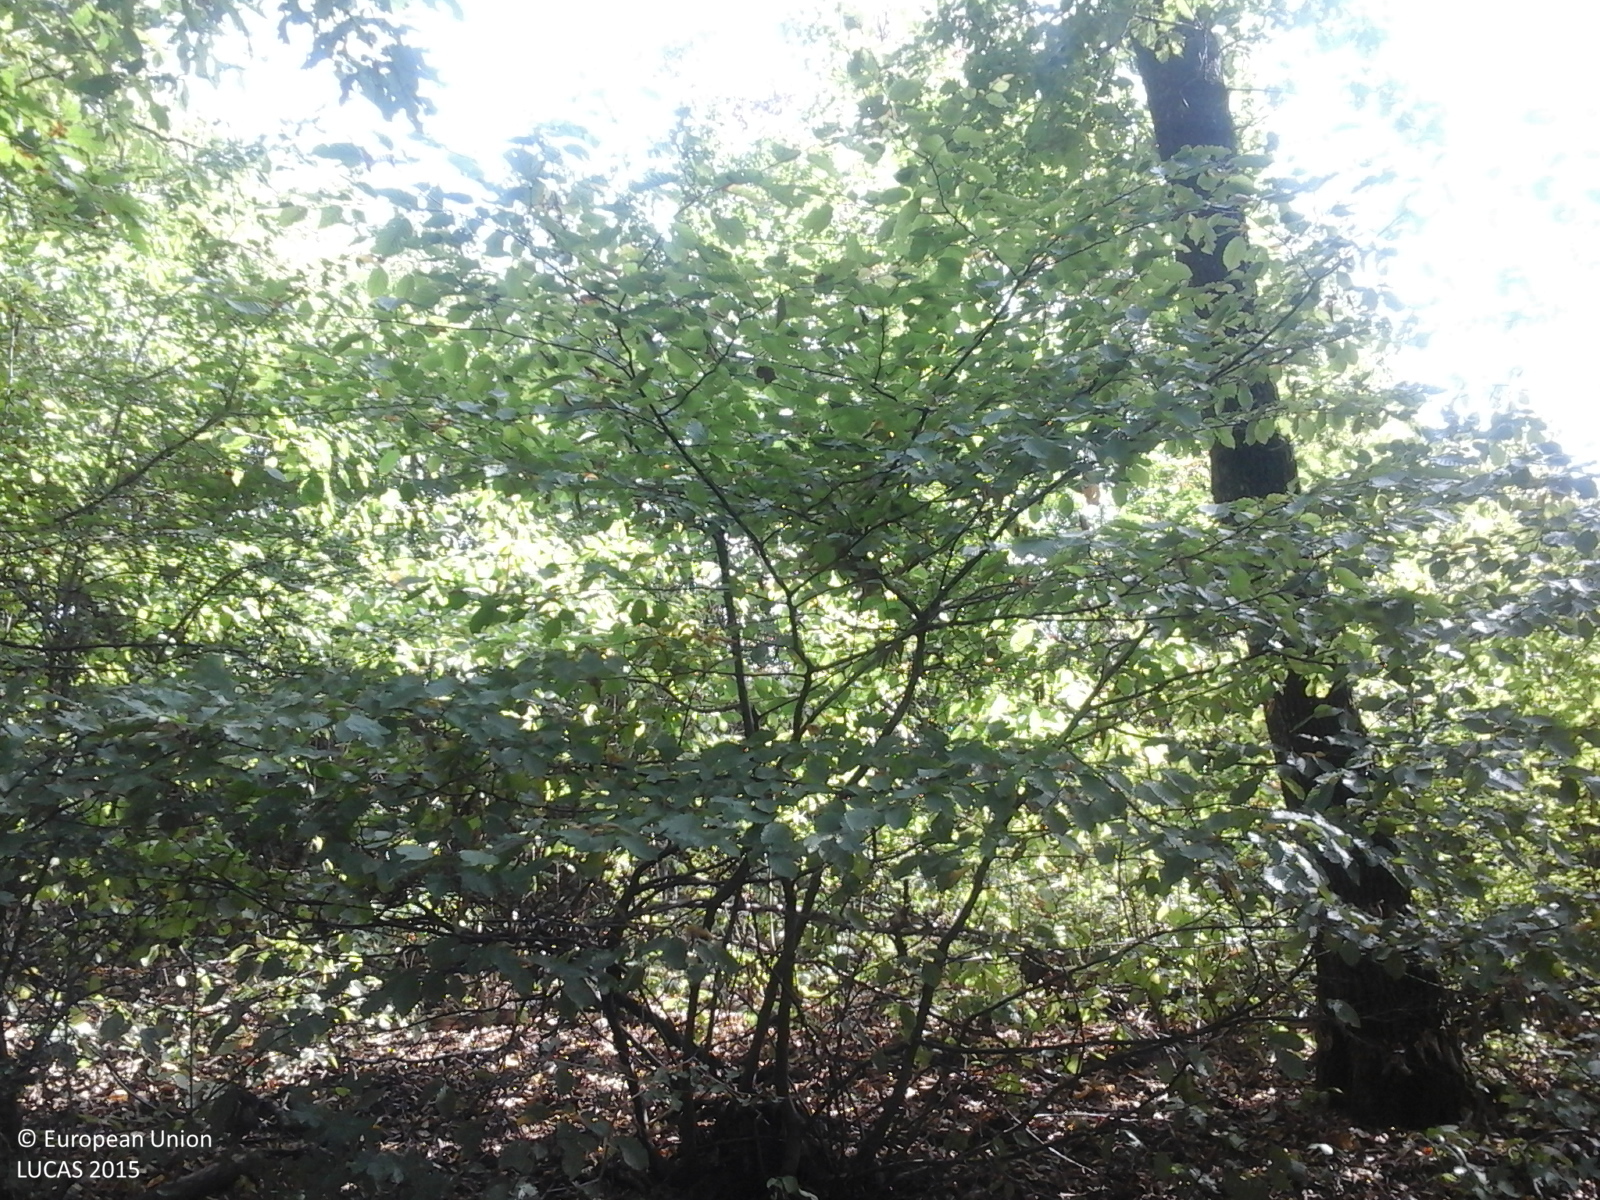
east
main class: Woodland
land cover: Broadleaved woodland
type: acidophilous oak and oak-birch forest
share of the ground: > 75 %
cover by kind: broadleaved forest trees 100 %
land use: Forestry
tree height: > 5 m
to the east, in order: Broadleaved woodland; Grassland without tree/shrub cover; Other fruit trees and berries; Tracks; Other fruit trees and berries
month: September
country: RO
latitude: 47.1261
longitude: 23.2627
